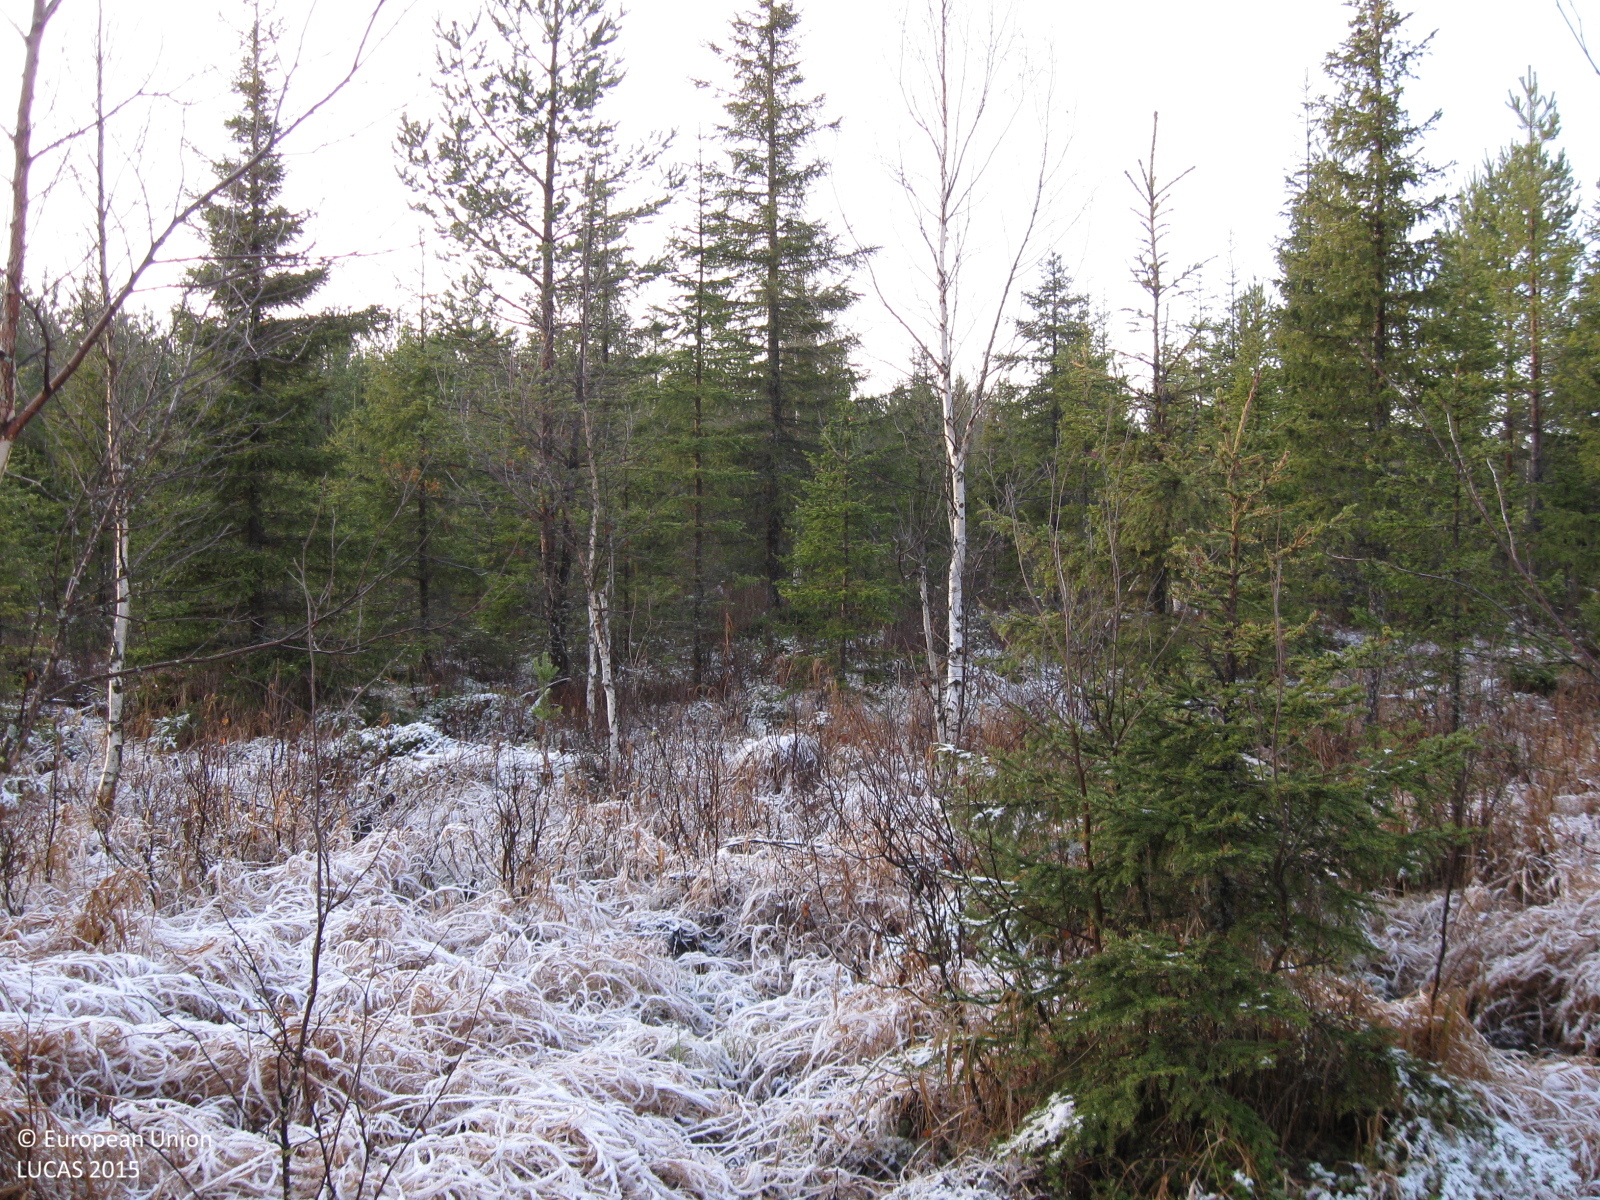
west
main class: Woodland
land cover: Spruce dominated mixed woodland
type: mire and swamp forests
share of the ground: 25 - 50 %
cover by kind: herbaceous plants 65 %, broadleaved forest trees 25 %, coniferous forest trees 10 %
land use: Forestry
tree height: < 5 m
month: October
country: SE
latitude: 66.2793
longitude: 20.7645
